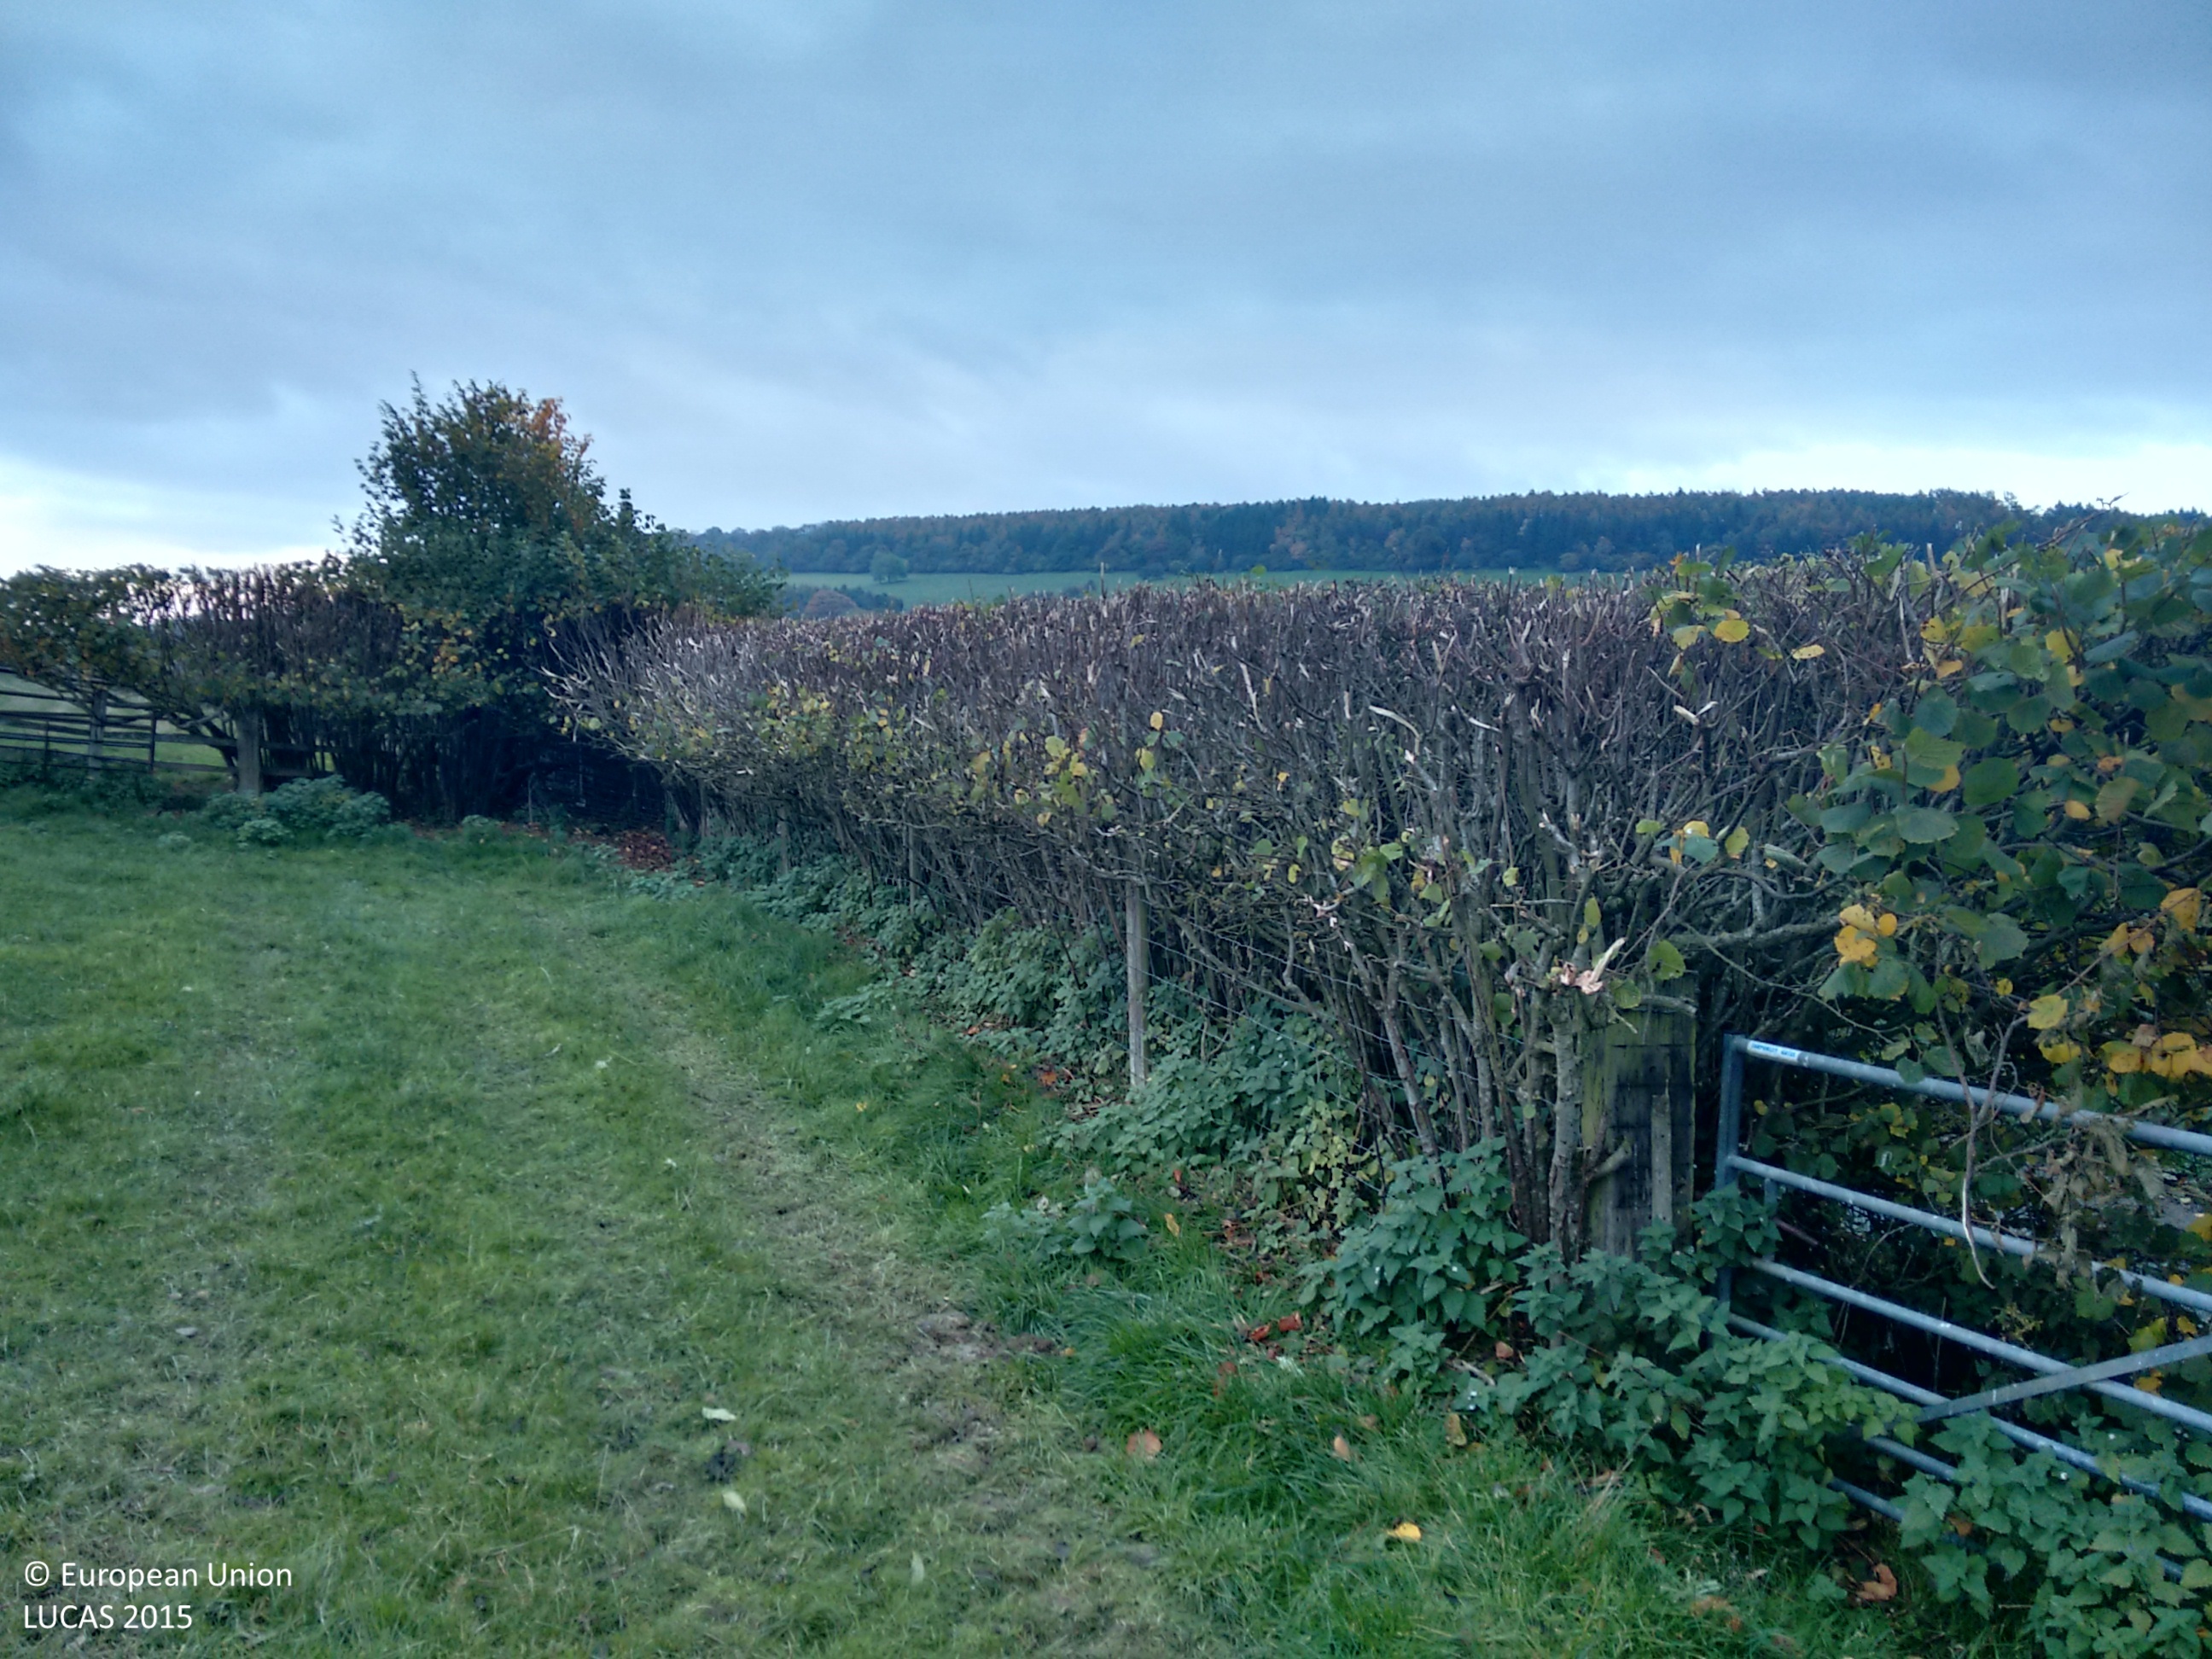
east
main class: Grassland
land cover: Grassland without tree/shrub cover
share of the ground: > 75 %
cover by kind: herbaceous plants 100 %
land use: Agriculture (excluding fallow land and kitchen gardens)
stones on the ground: < 10 %
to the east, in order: Grassland without tree/shrub cover; Fences; Managed hedges; Grass margins; Paved roads, cycling and walking lanes; Grass margins; Managed hedges; Fences; Grassland without tree/shrub cover; Fences; Ditches and canals; Fences; Grassland without tree/shrub cover
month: October
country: GB
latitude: 52.4877
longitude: -2.7502
